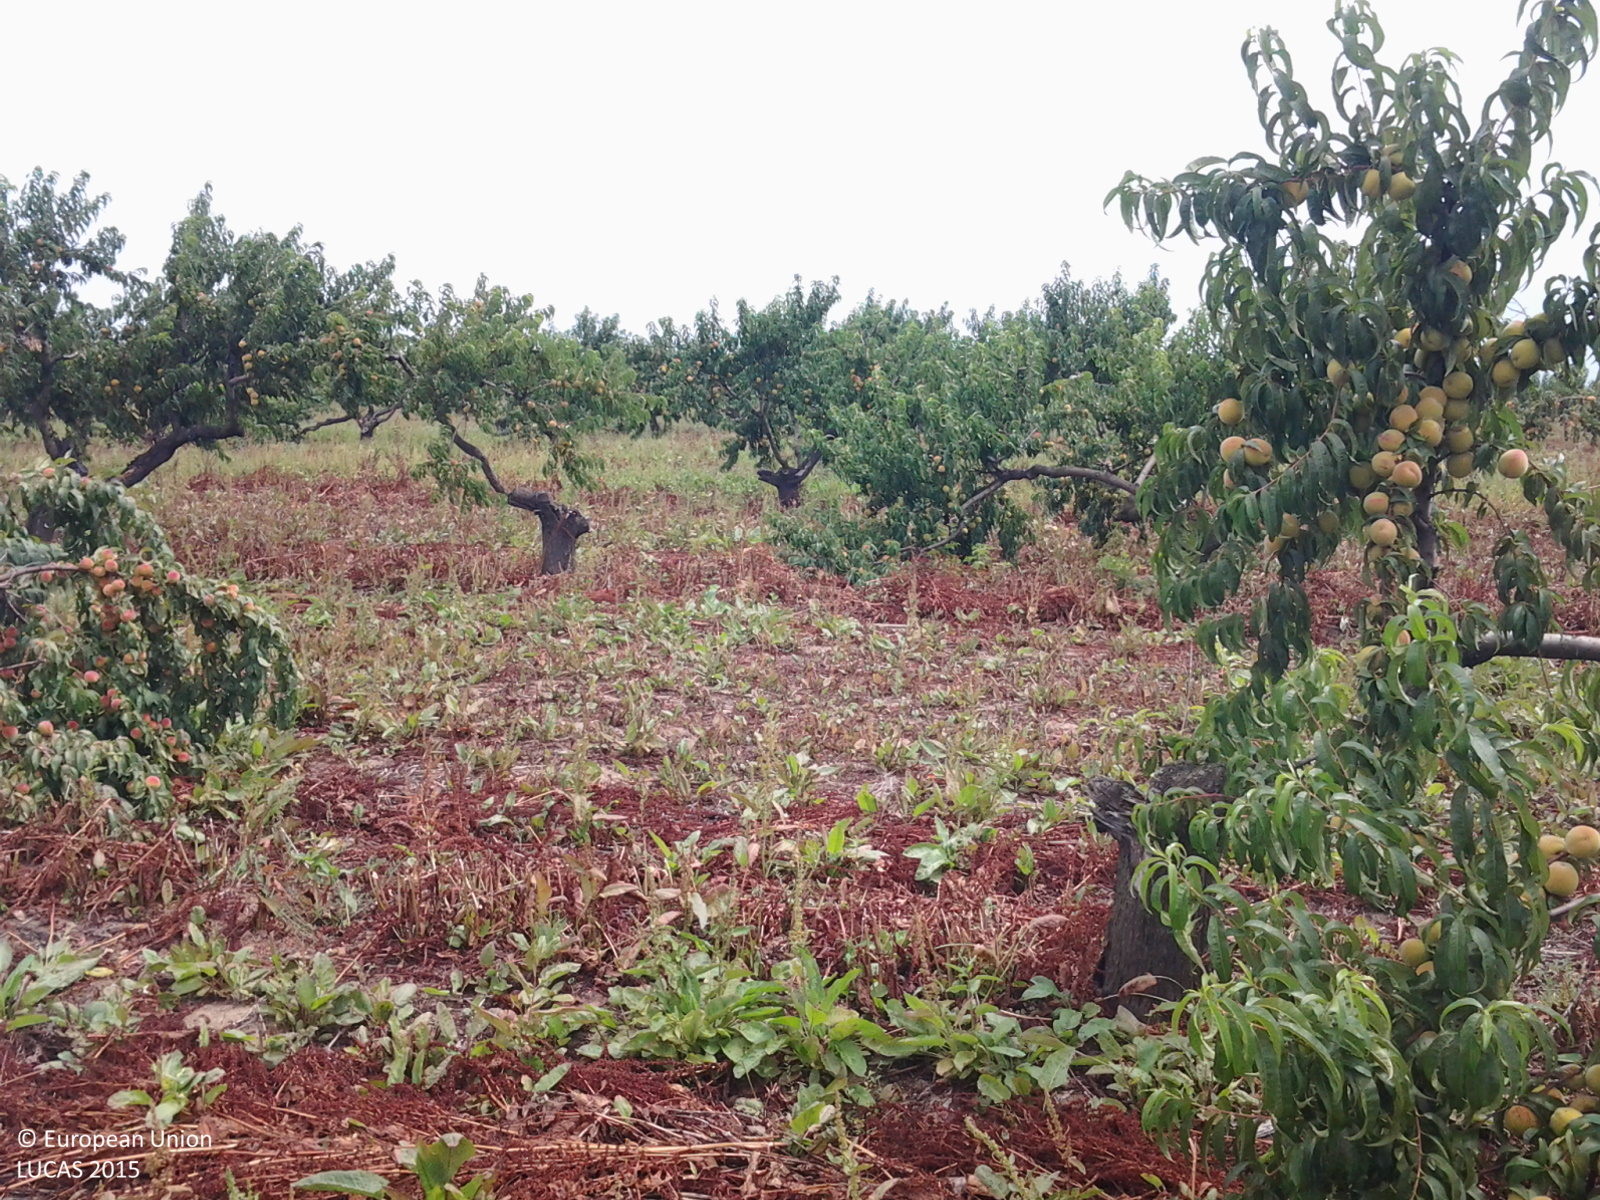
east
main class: Cropland
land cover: Other fruit trees and berries
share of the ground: 25 - 50 %
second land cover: Spontaneously vegetated surfaces
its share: 50 - 75 %
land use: Agriculture (excluding fallow land and kitchen gardens)
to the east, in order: Other fruit trees and berries; Spontaneously vegetated surfaces; Grass margins; Tracks; Grass margins; Maize
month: July
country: HU
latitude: 47.2685
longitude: 20.4848
